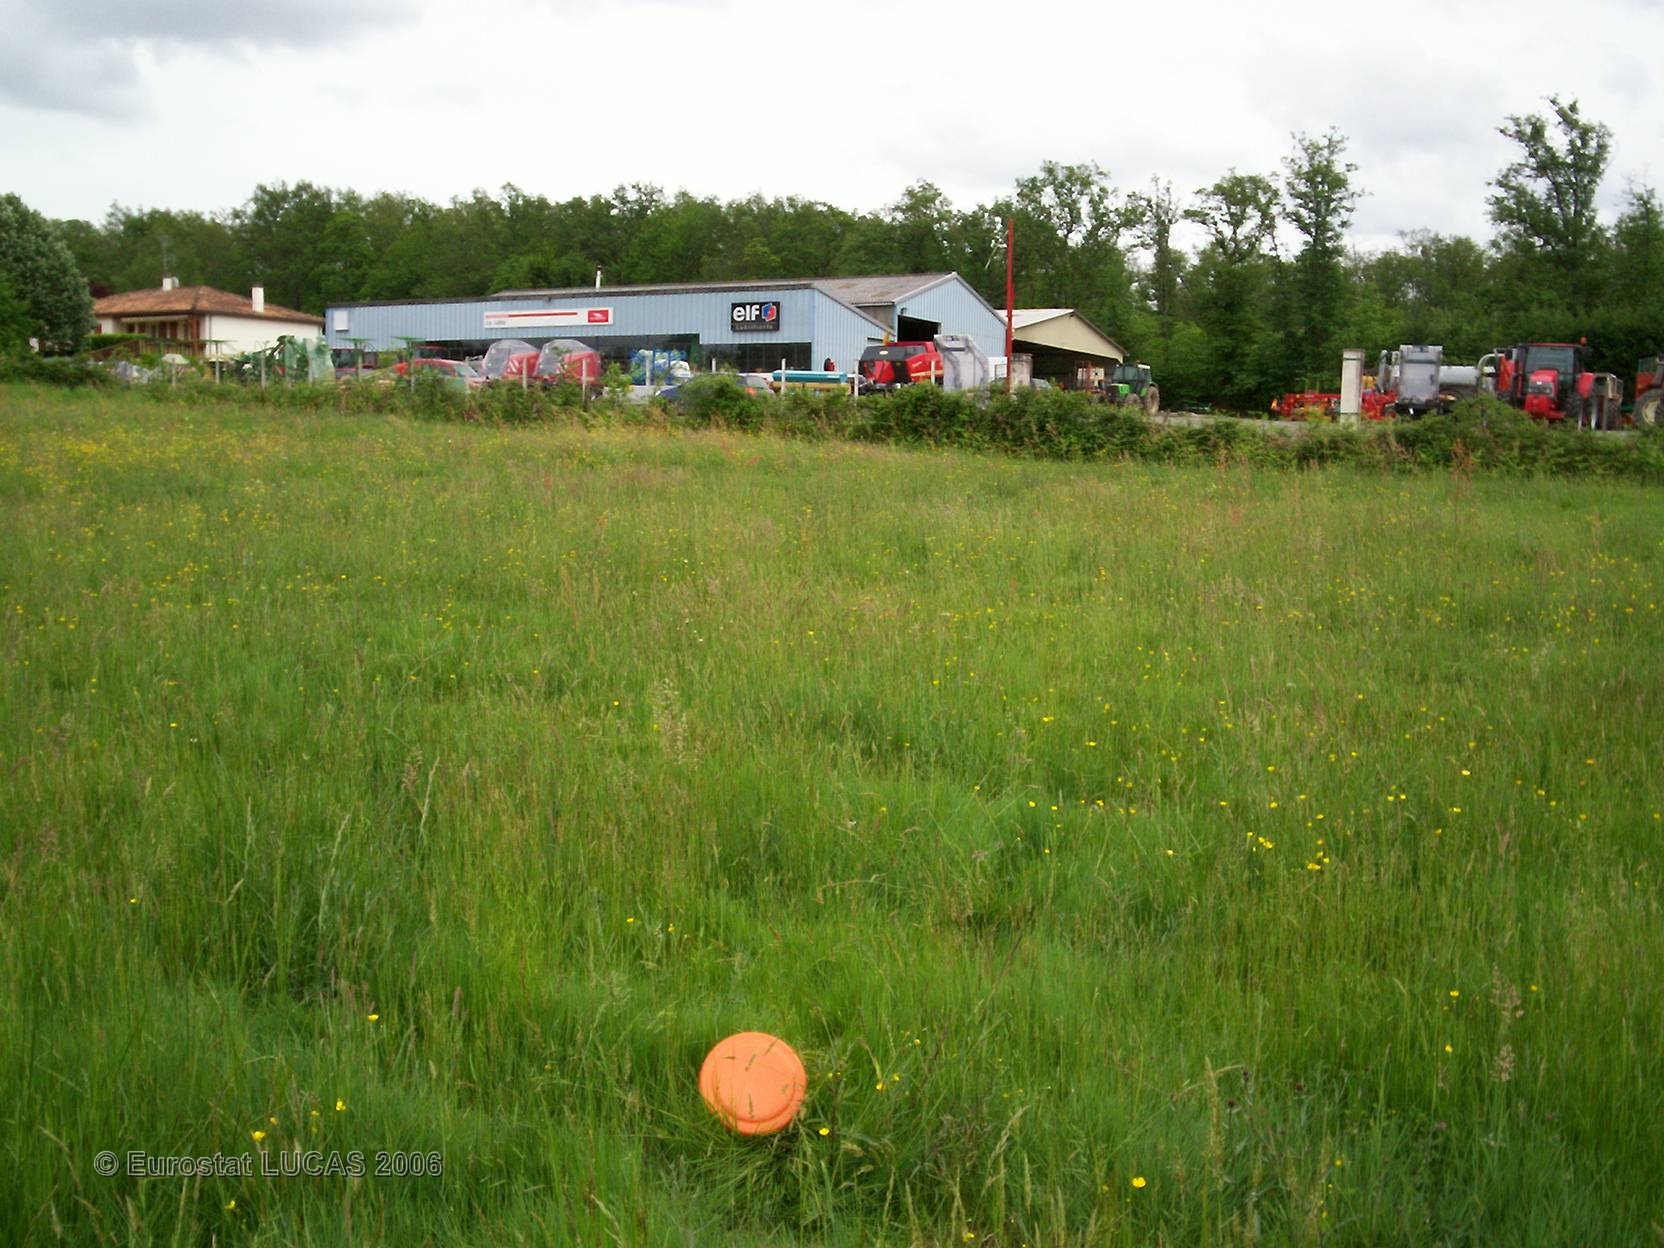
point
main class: Grassland
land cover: Grassland without tree/shrub cover
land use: Agriculture (excluding fallow land and kitchen gardens)
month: May
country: FR
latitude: 45.7811
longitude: 0.6880
